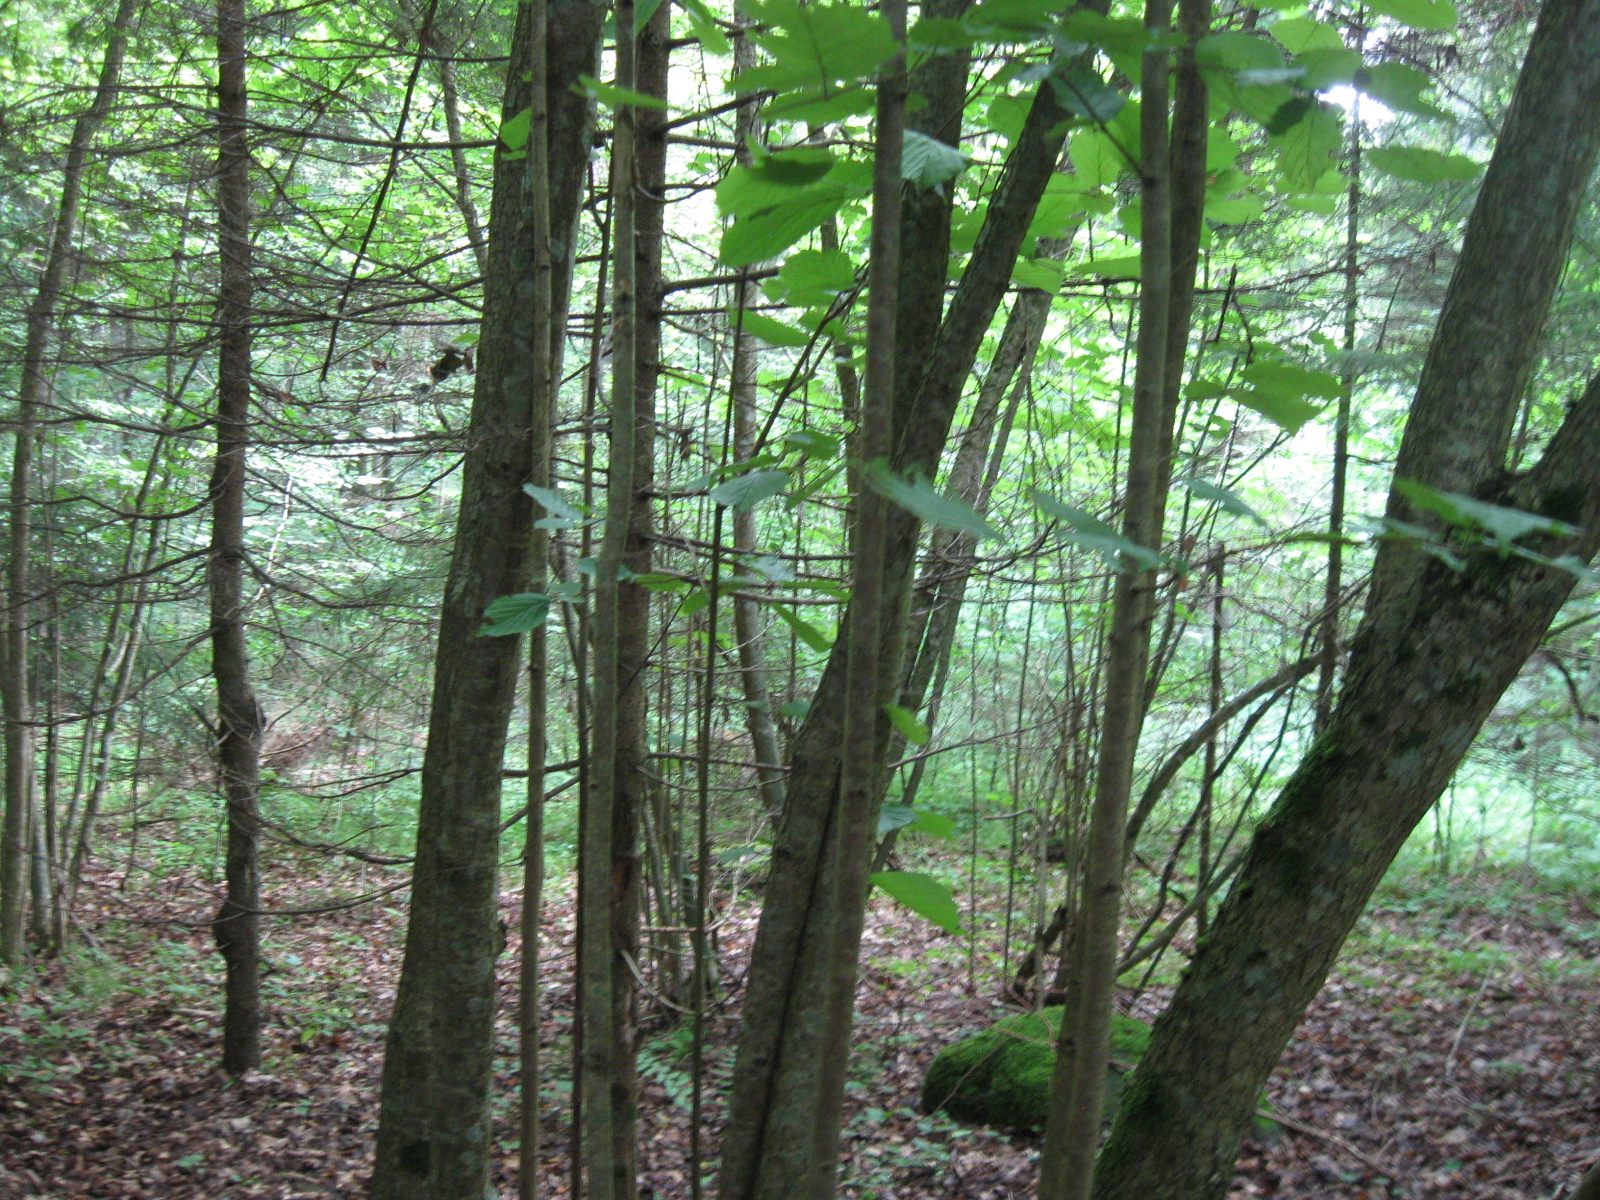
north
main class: Woodland
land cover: Other mixed woodland
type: hemiboreal forest and nemoral coniferous forest and mixed broadleaved-coniferous forest
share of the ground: > 75 %
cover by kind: broadleaved forest trees 65 %, coniferous forest trees 30 %, herbaceous plants 5 %
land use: Forestry
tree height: > 5 m
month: July
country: LT
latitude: 54.3602
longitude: 24.2714
